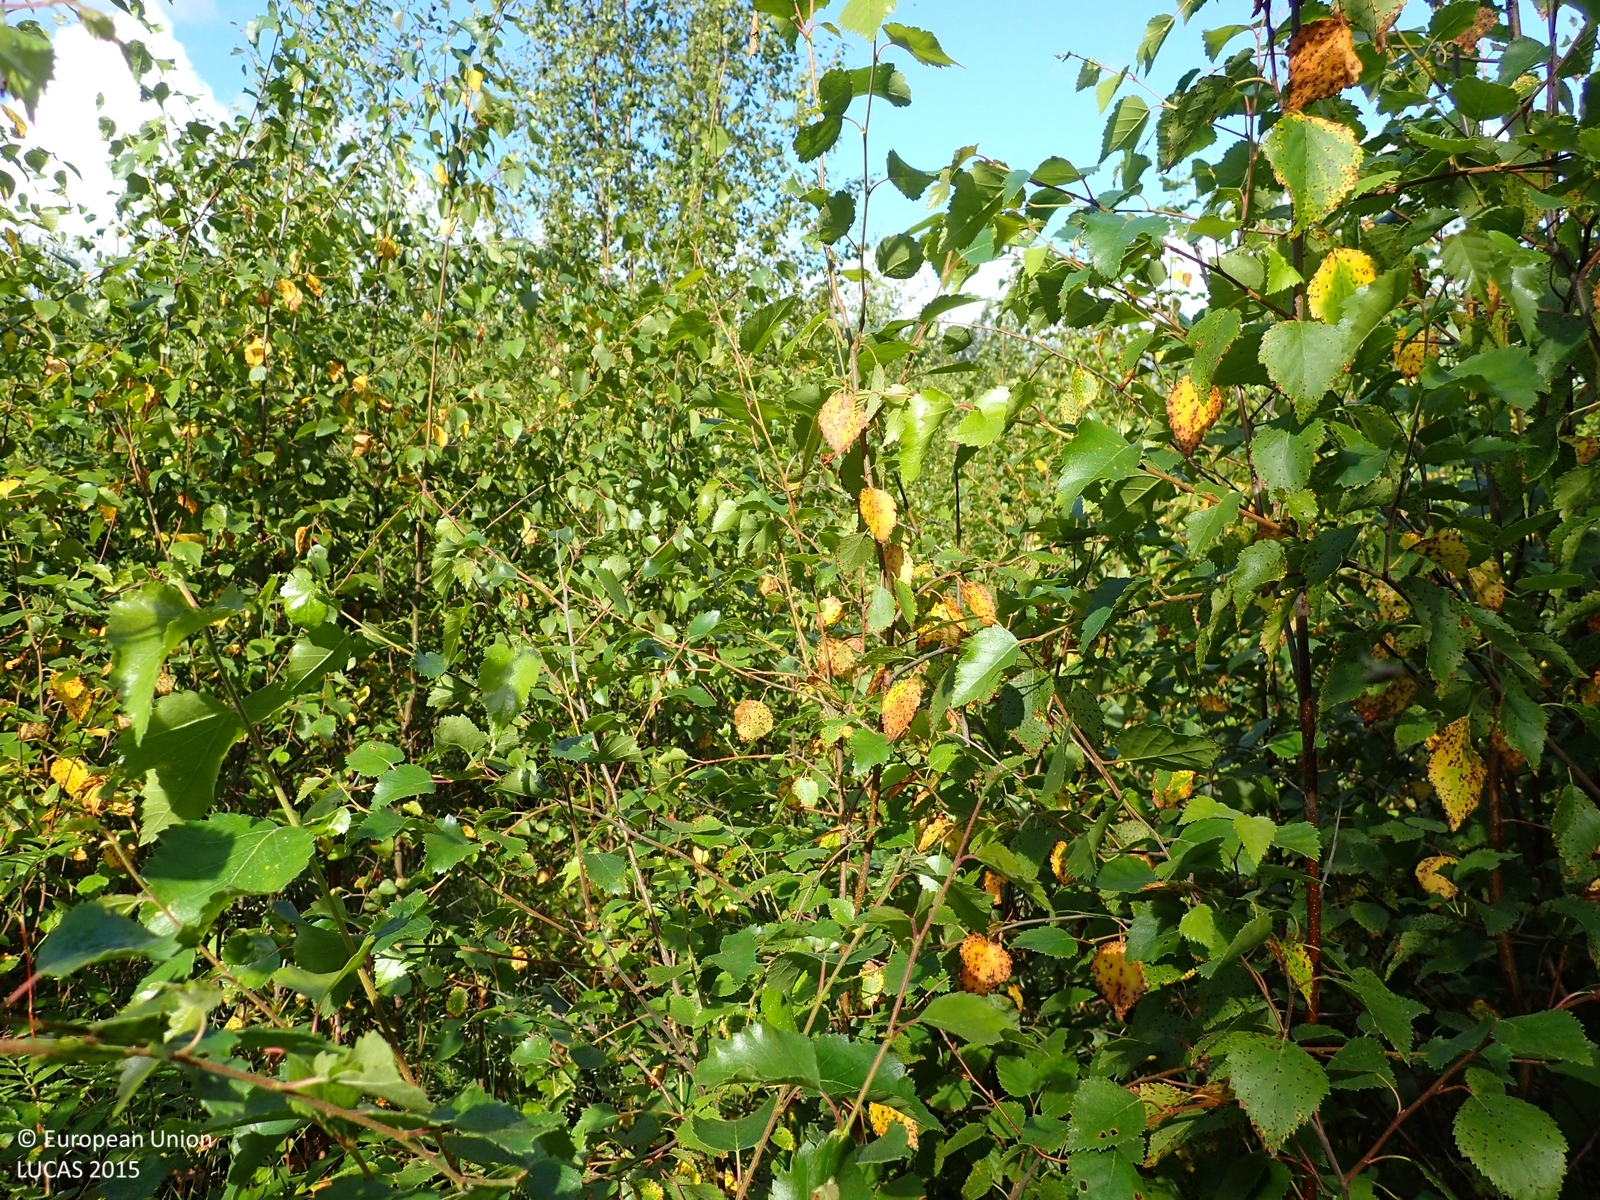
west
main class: Woodland
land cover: Broadleaved woodland
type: non-riverine alder, birch or aspen forest
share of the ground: > 75 %
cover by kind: broadleaved forest trees 90 %, herbaceous plants 10 %
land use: Forestry
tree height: < 5 m
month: August
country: FI
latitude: 62.7159
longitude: 21.9949
